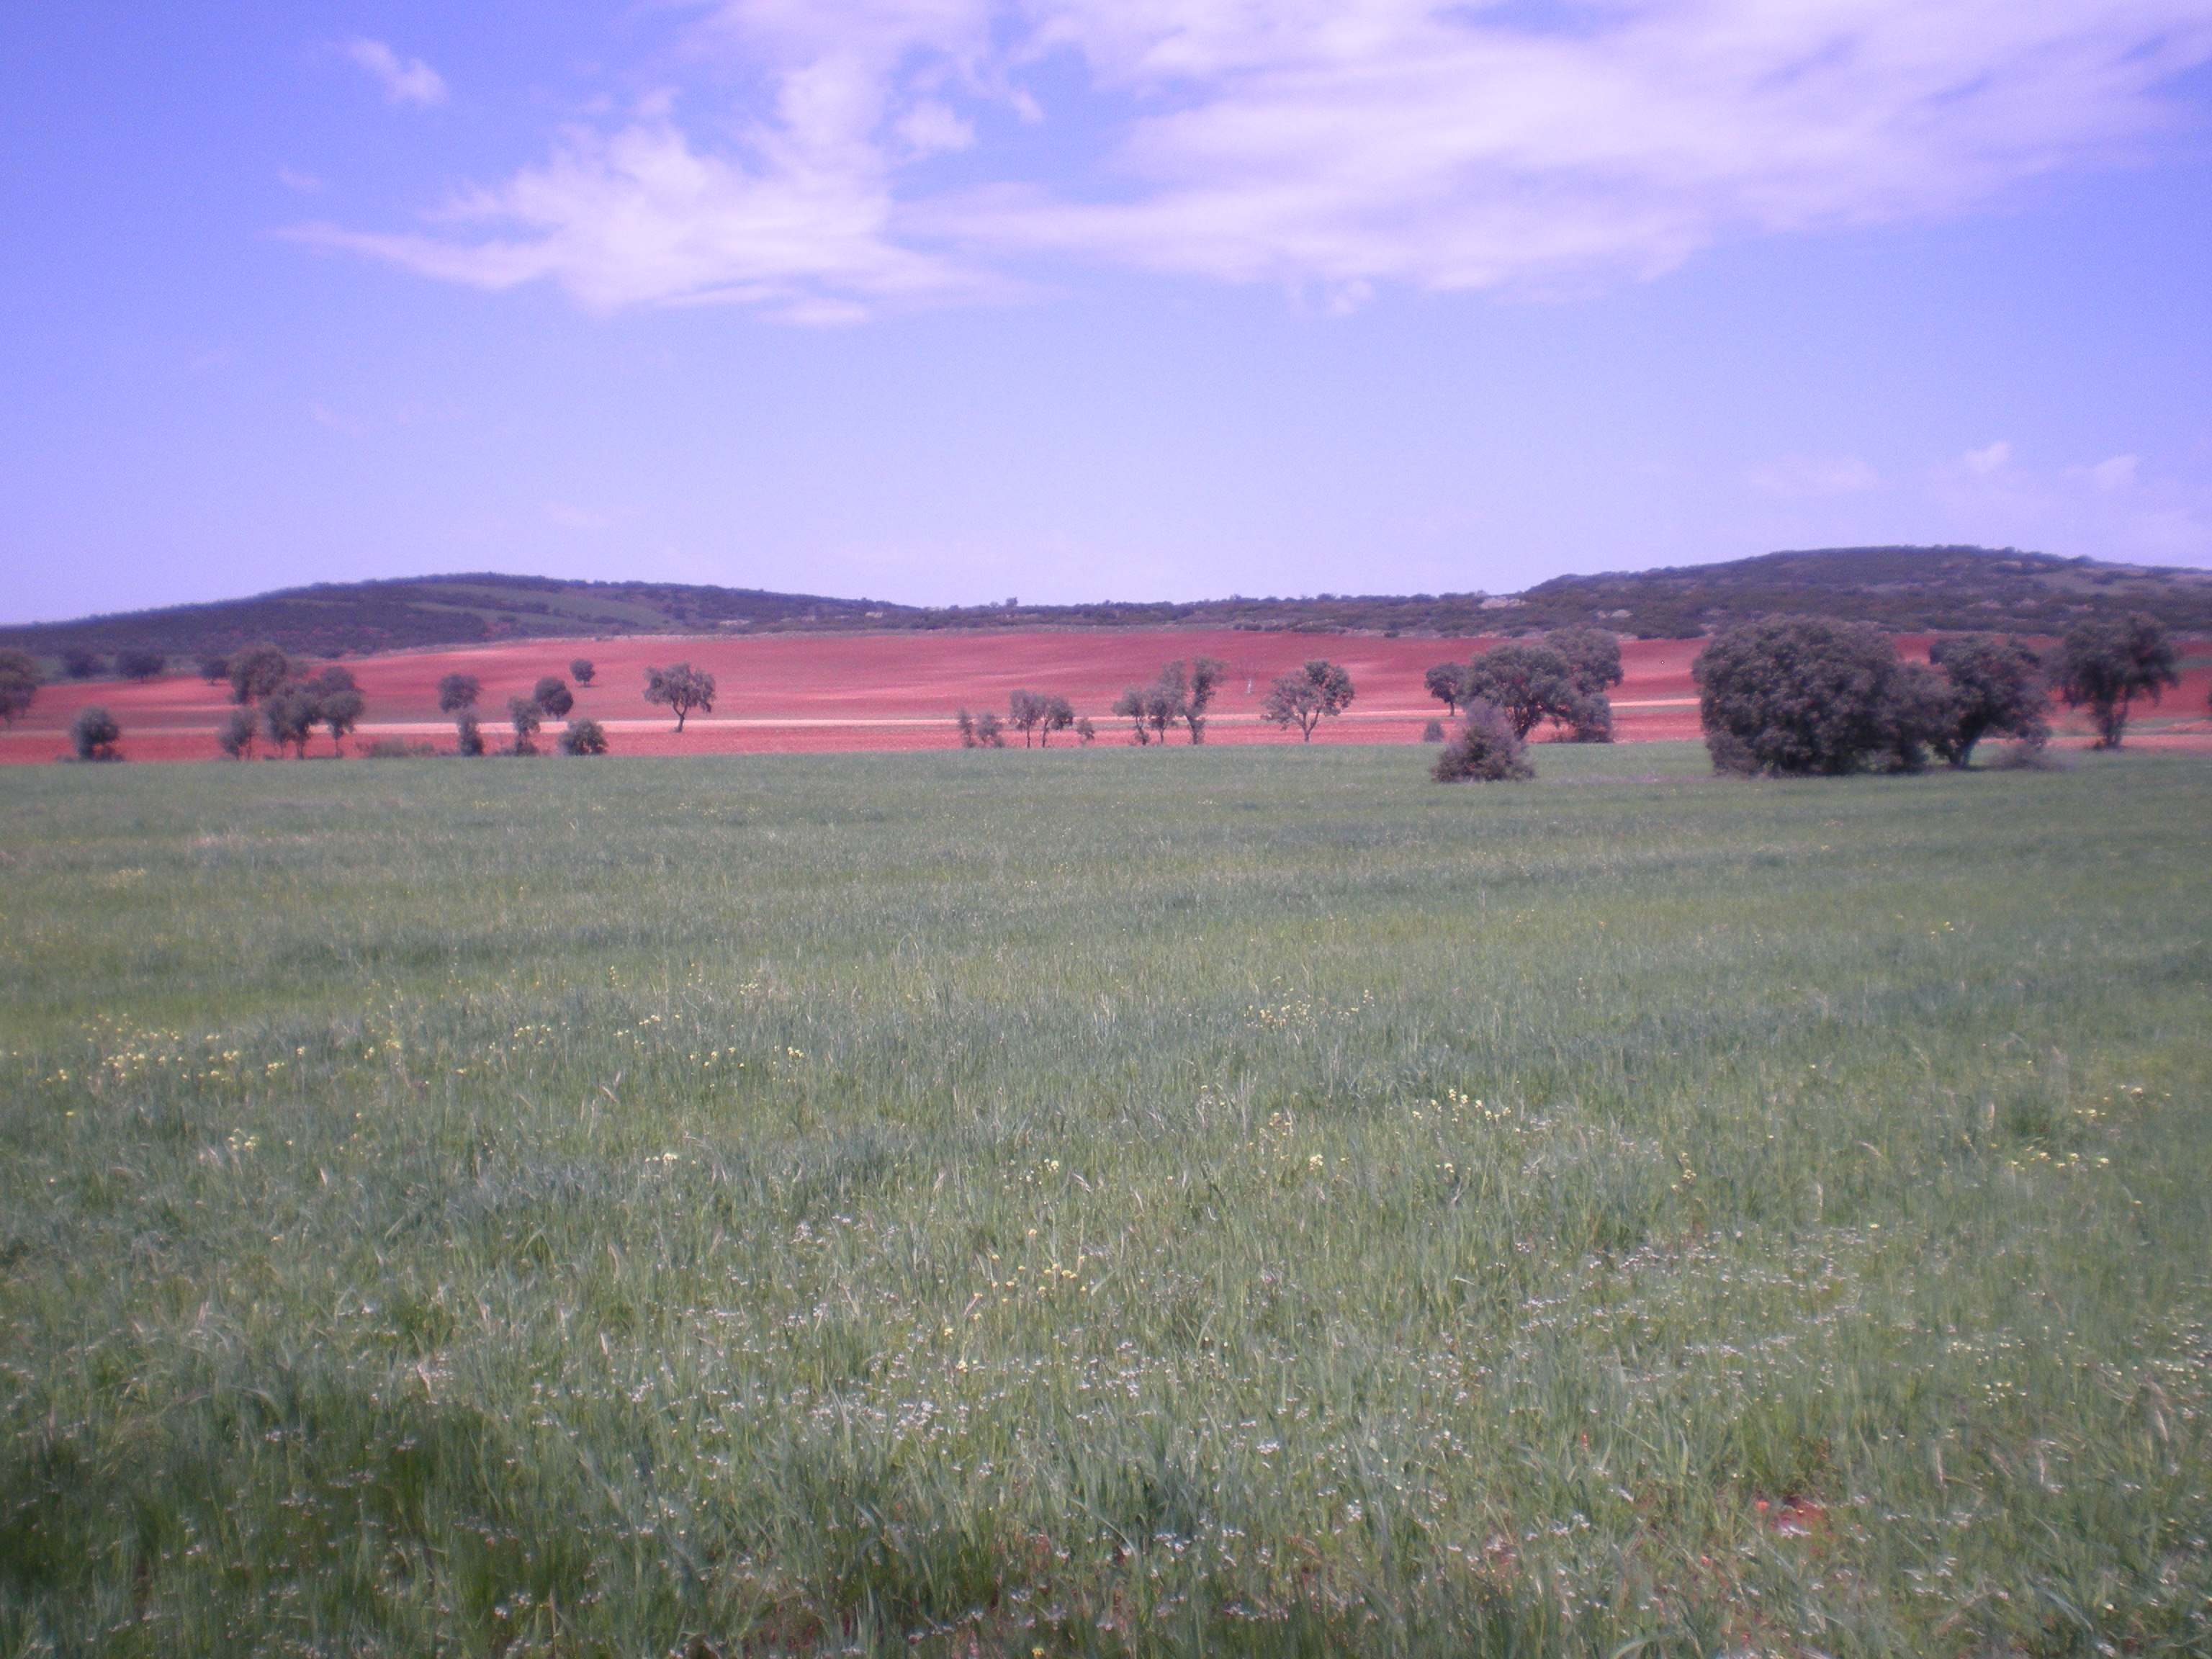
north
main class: Cropland
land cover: Oats
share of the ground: > 75 %
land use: Agriculture (excluding fallow land and kitchen gardens)
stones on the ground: 10 - 25 %
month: April
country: ES
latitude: 38.5964
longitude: -3.5009
